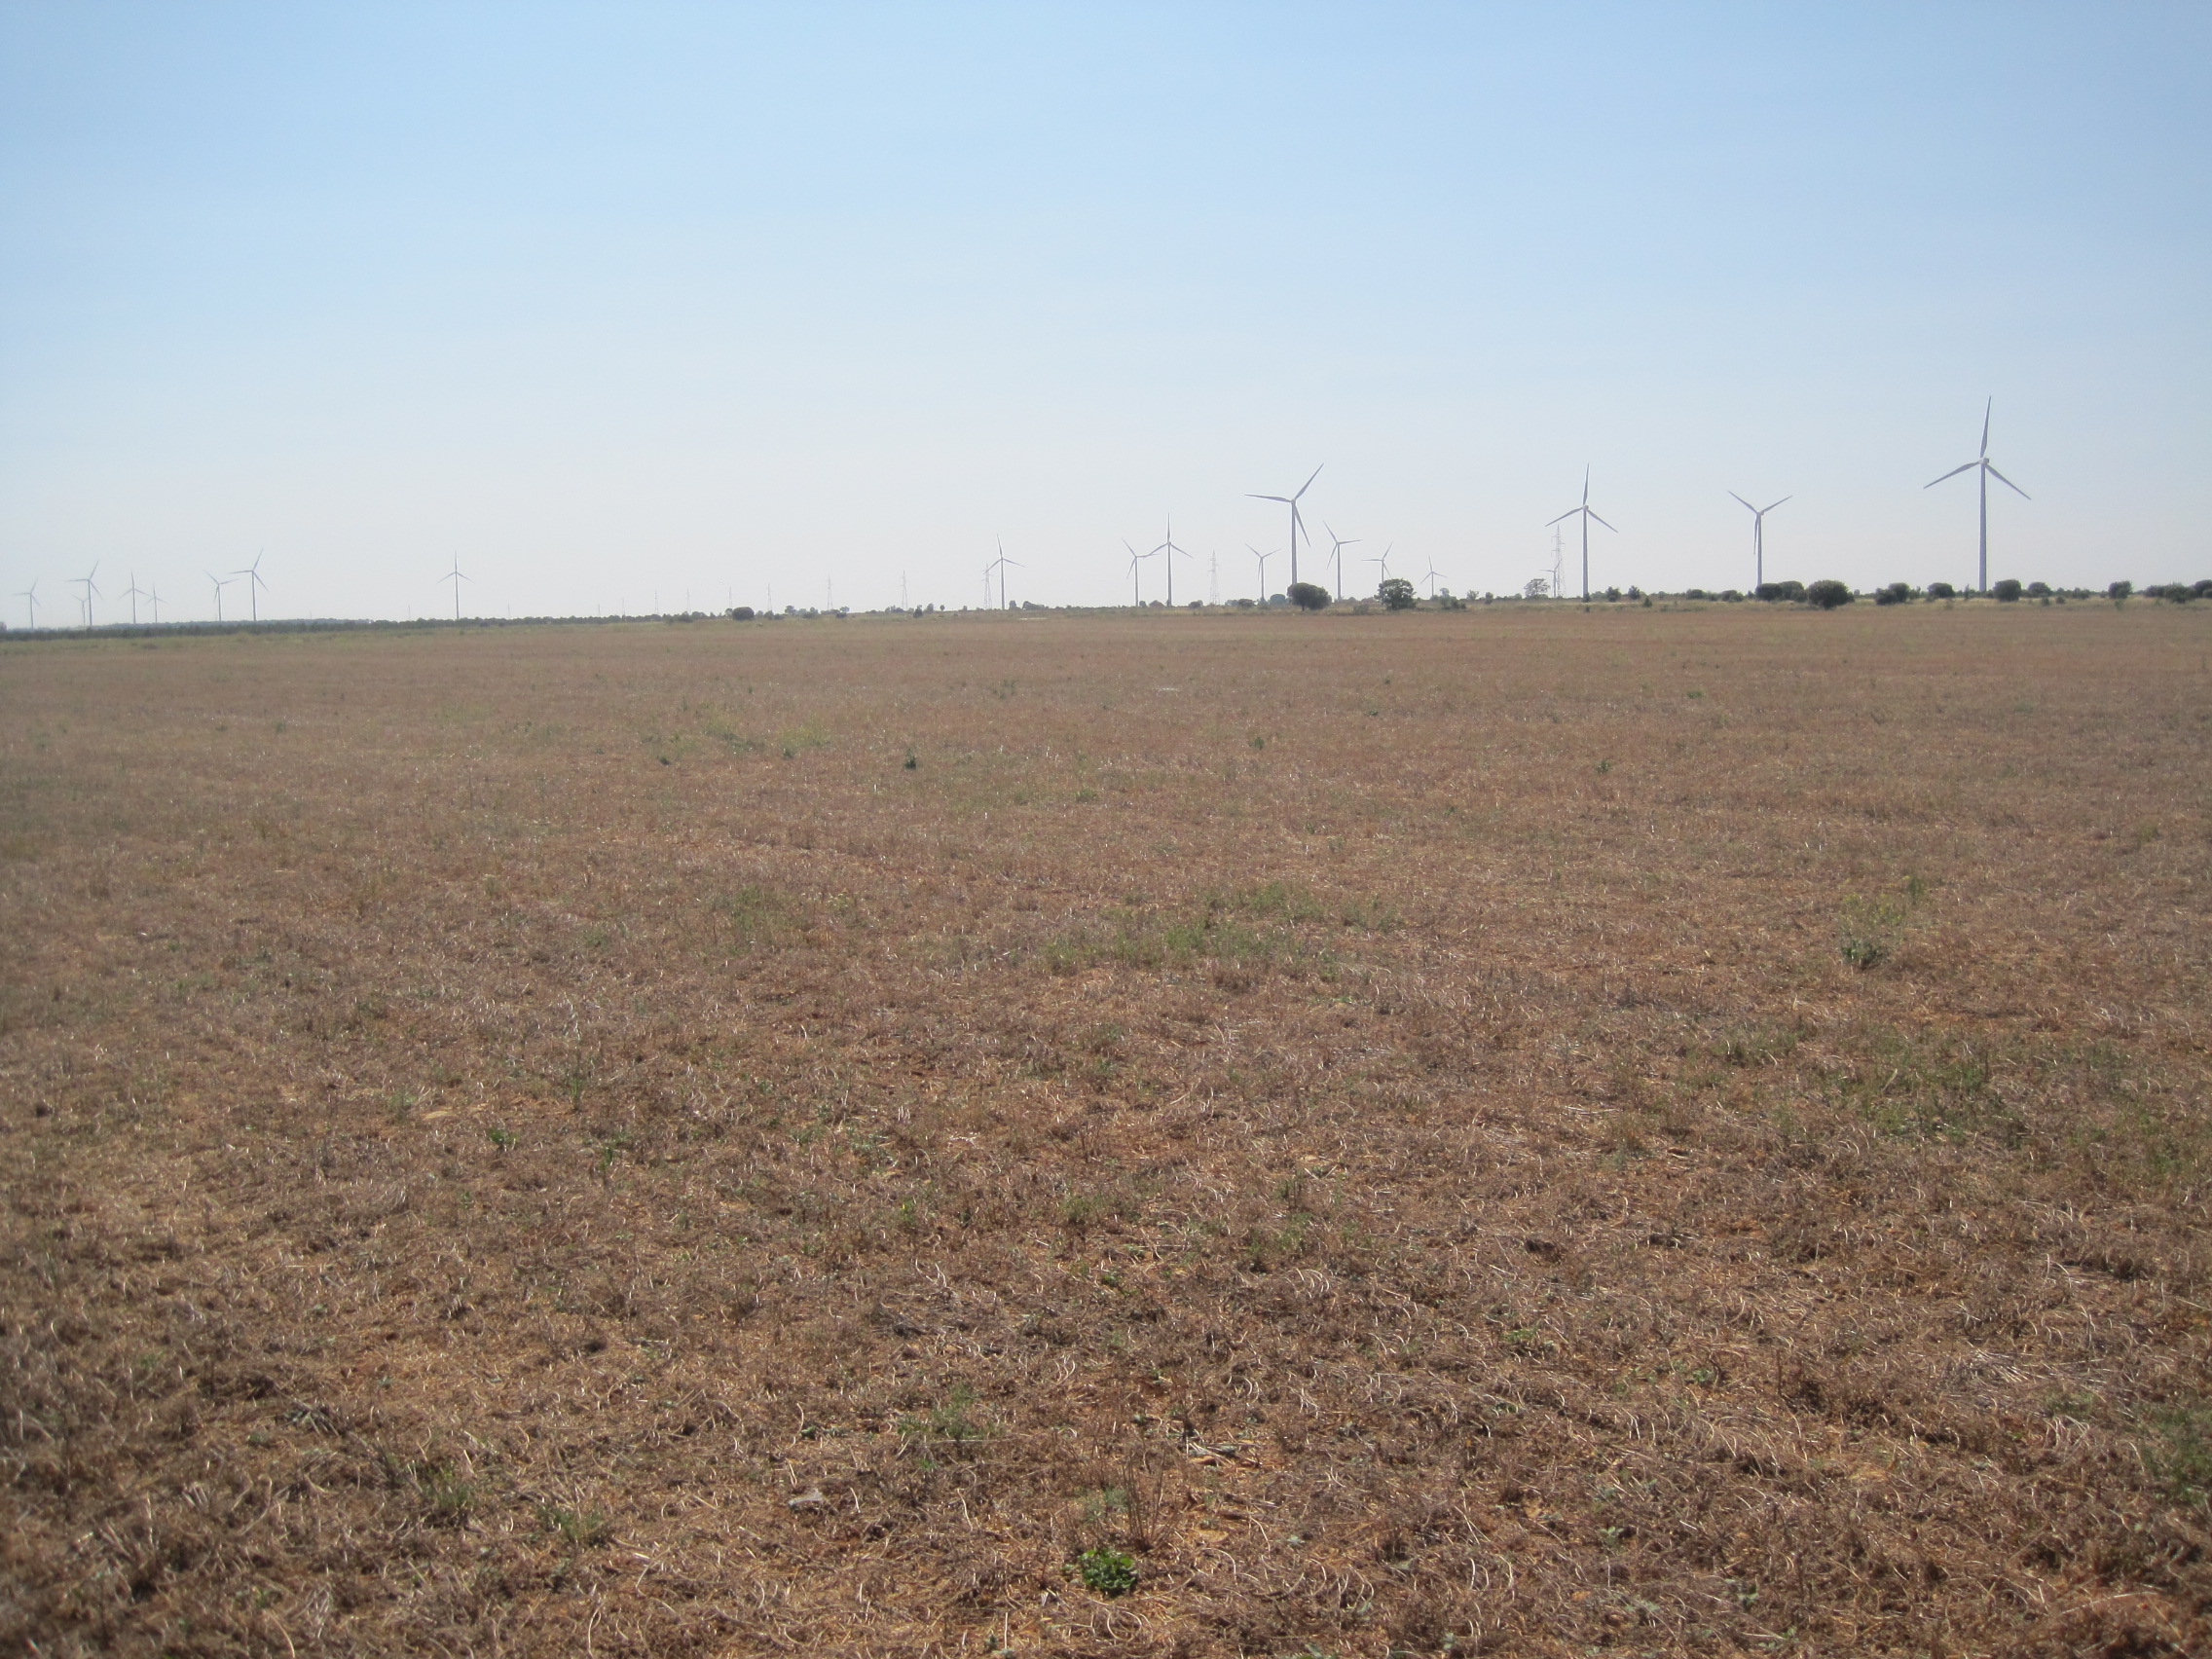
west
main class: Cropland
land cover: Dry pulses
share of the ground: < 10 %
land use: Agriculture (excluding fallow land and kitchen gardens)
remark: Harvested field
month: July
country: ES
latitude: 41.8985
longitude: -4.7418
